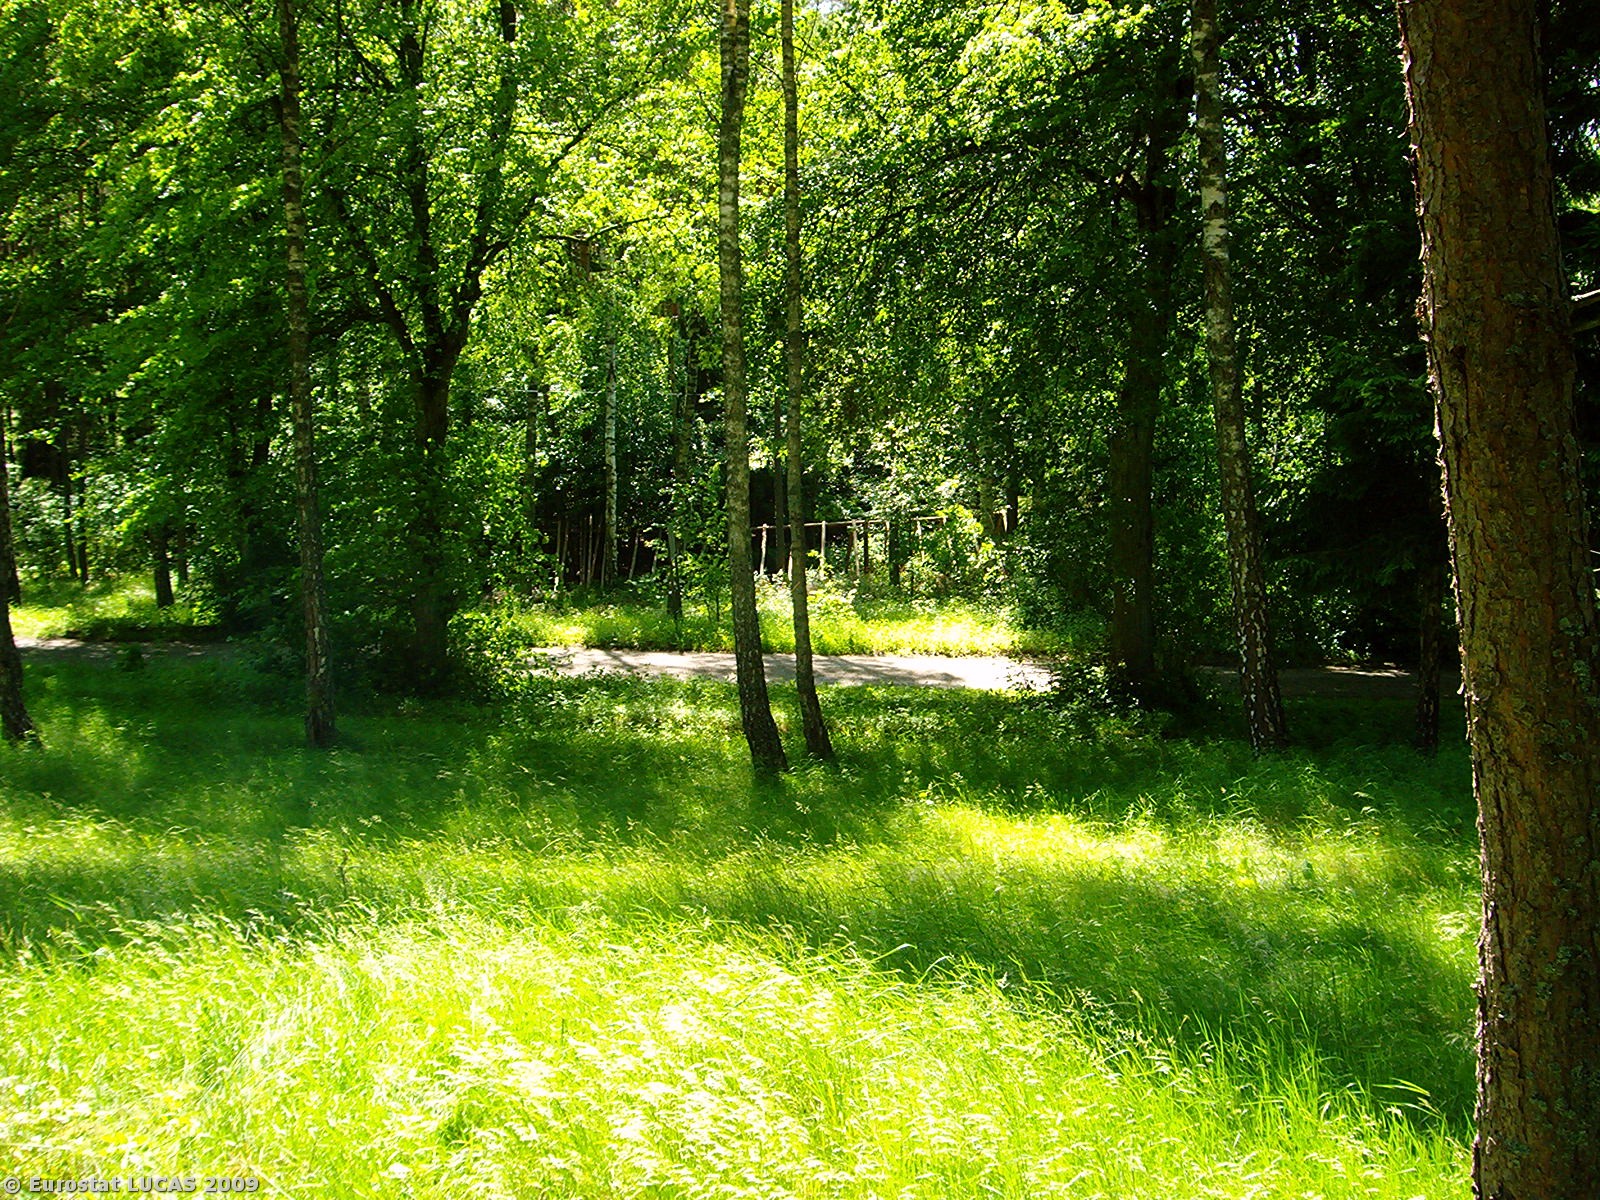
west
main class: Woodland
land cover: Mixed woodland
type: hemiboreal forest and nemoral coniferous forest and mixed broadleaved-coniferous forest
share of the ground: 50 - 75 %
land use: Forestry
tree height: > 5 m
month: June
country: PL
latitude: 53.9447
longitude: 17.2160
